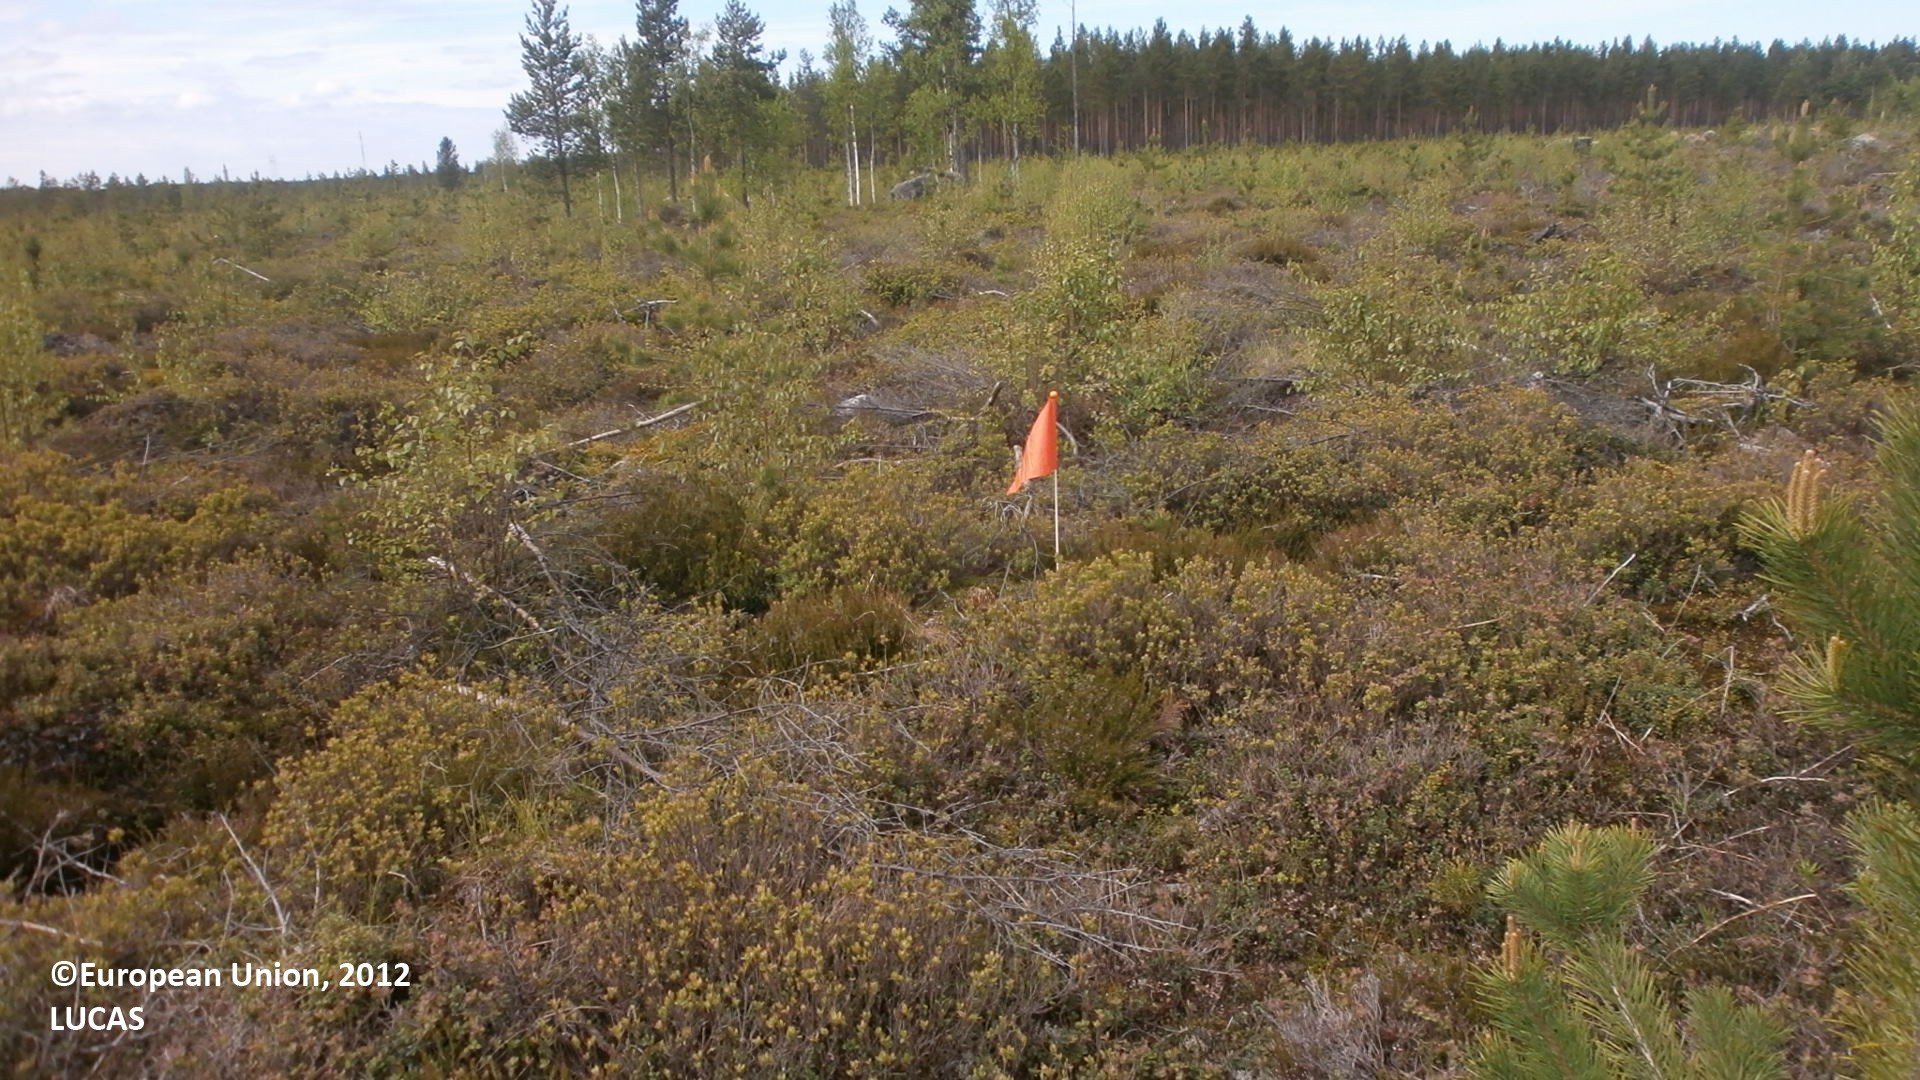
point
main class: Woodland
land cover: Other mixed woodland
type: hemiboreal forest and nemoral coniferous forest and mixed broadleaved-coniferous forest
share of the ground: 10 - 25 %
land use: Forestry
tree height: < 5 m
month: June
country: FI
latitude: 64.4701
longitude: 25.0323
